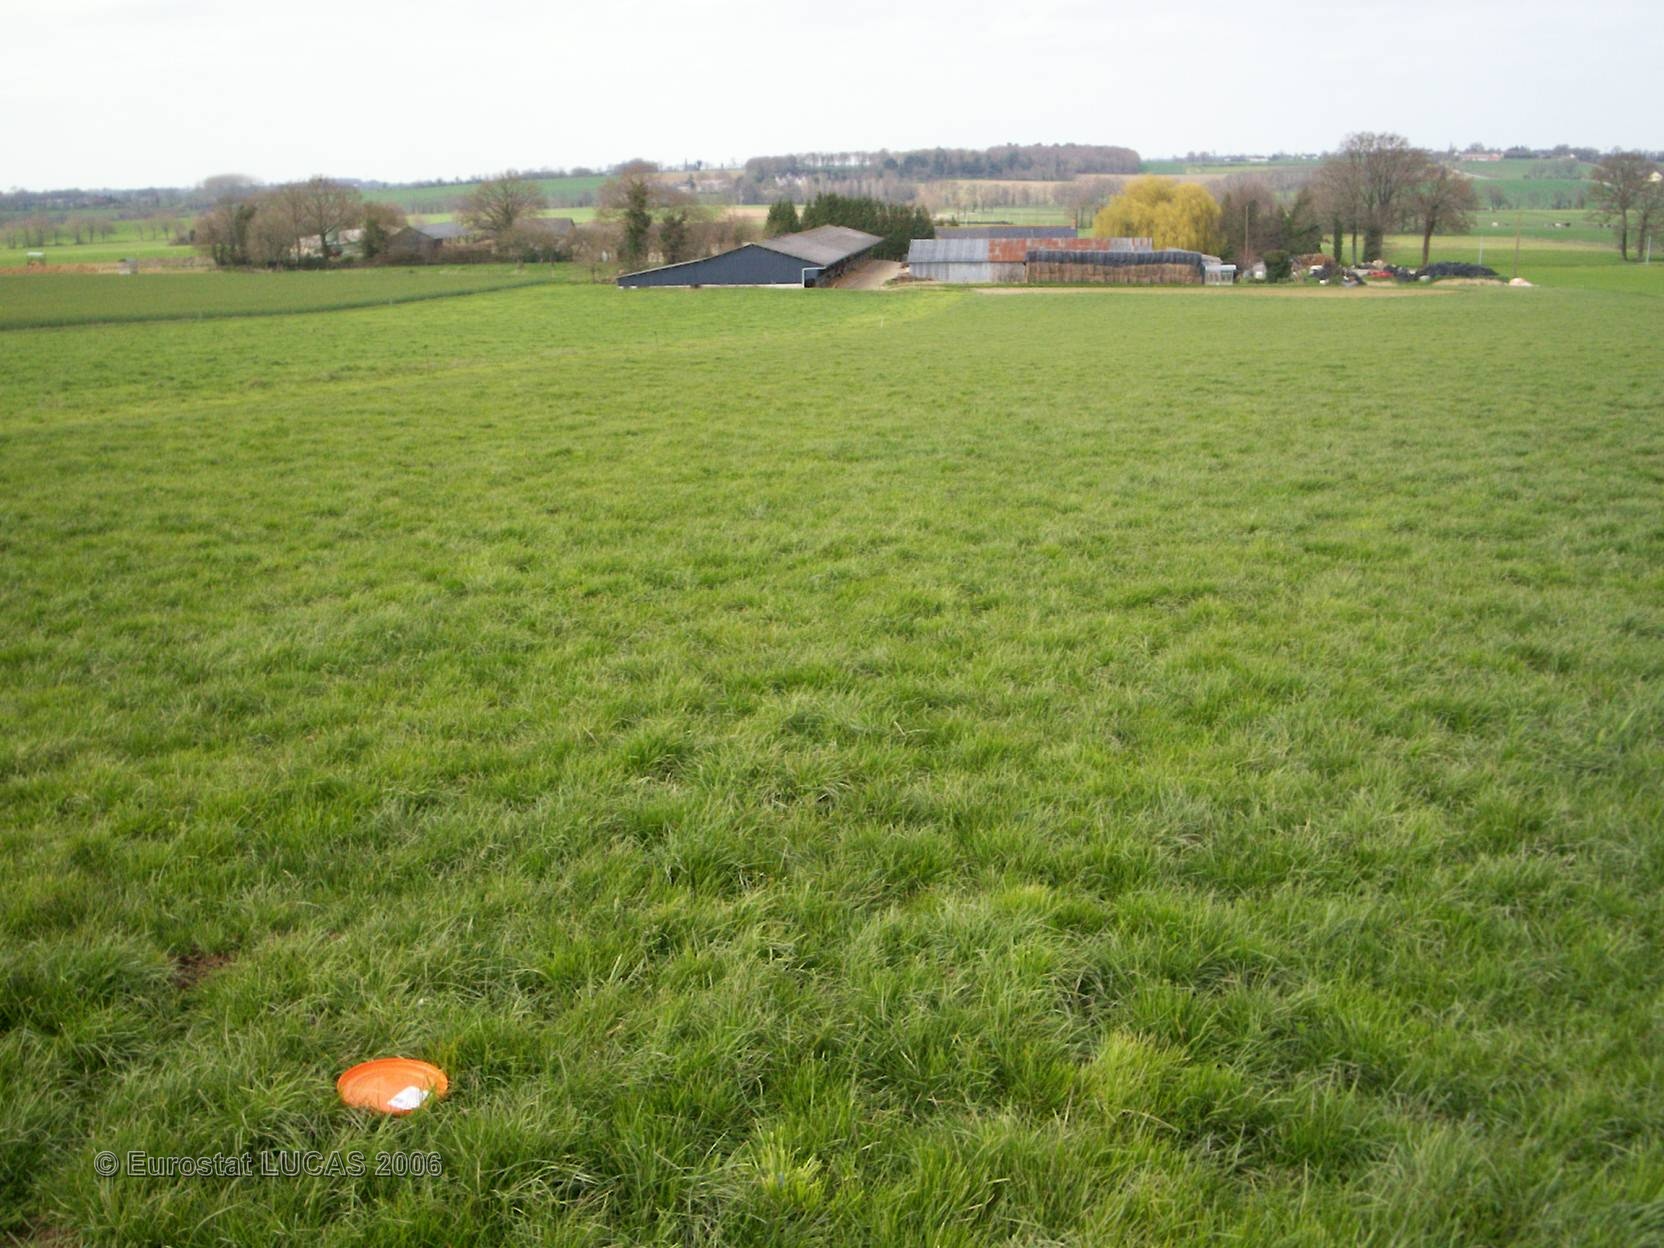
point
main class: Grassland
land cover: Grassland without tree/shrub cover
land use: Agriculture (excluding fallow land and kitchen gardens)
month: April
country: FR
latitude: 47.9390
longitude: -1.5719
